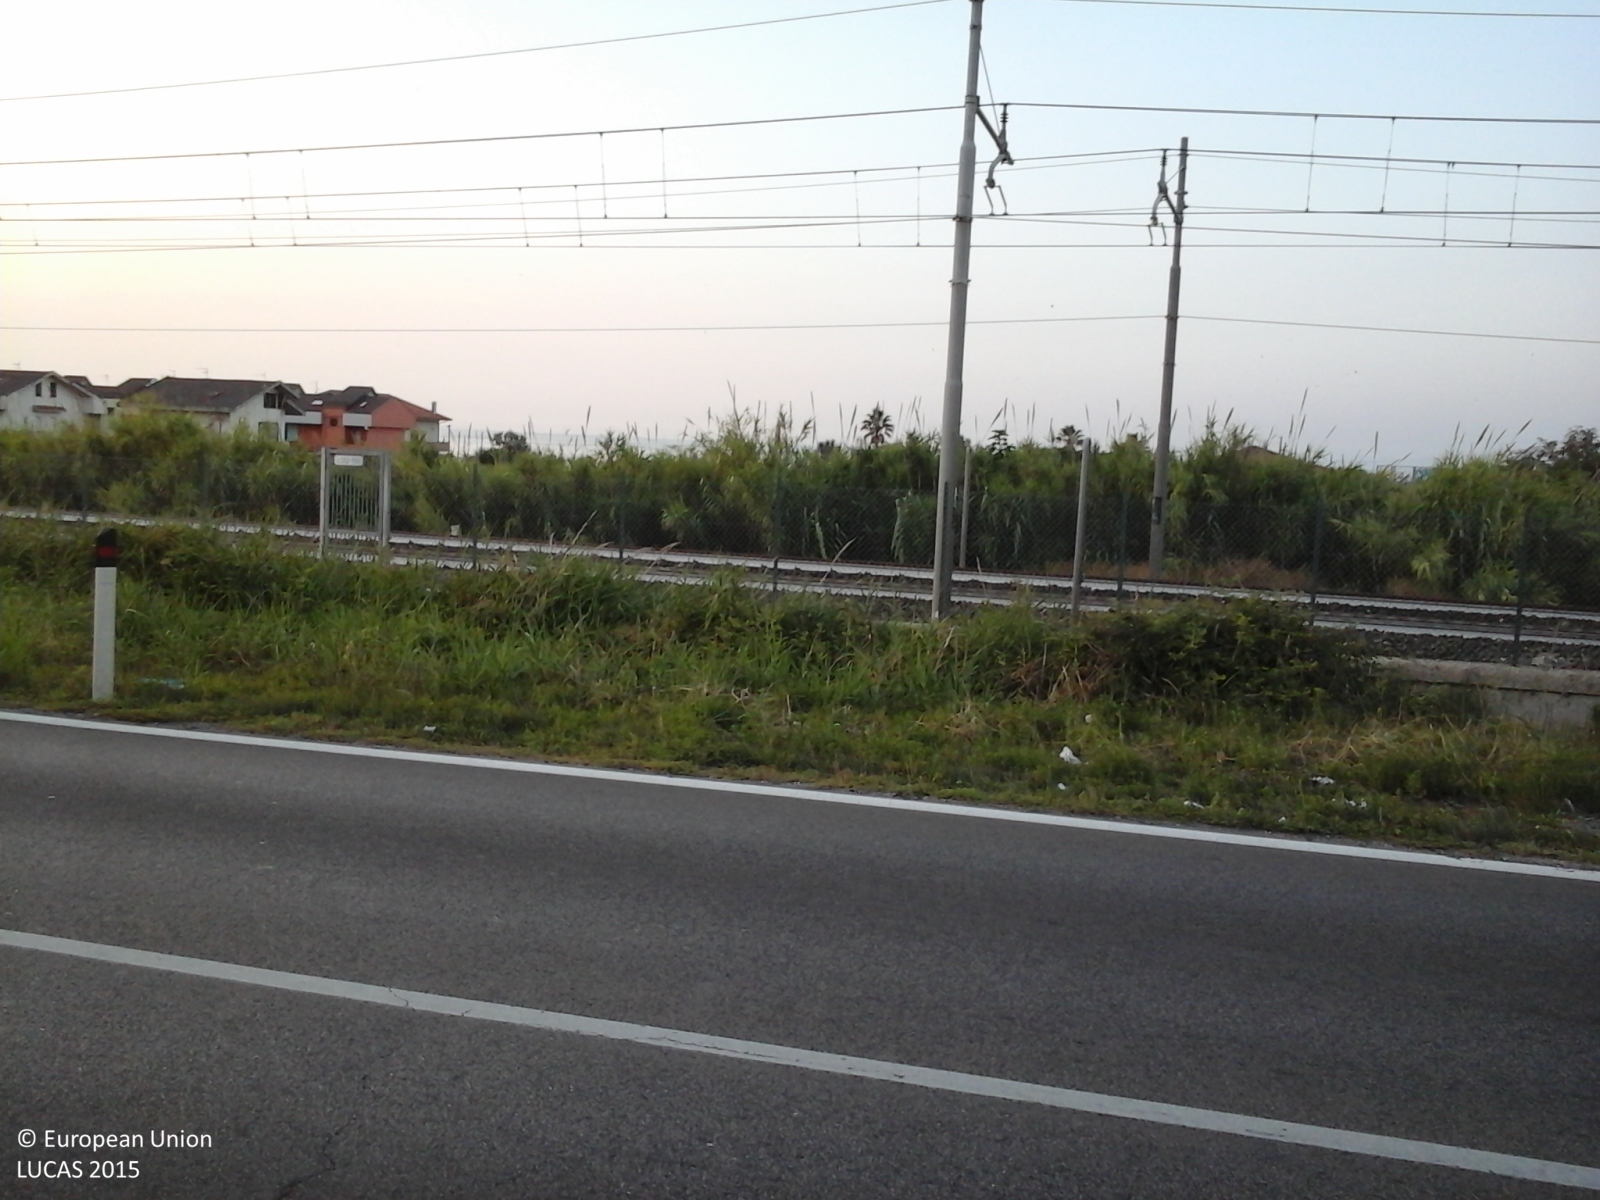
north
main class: Grassland
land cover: Grassland without tree/shrub cover
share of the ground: > 75 %
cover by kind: herbaceous plants 100 %
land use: Agriculture (excluding fallow land and kitchen gardens)
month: July
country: IT
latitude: 42.3989
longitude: 14.3244
